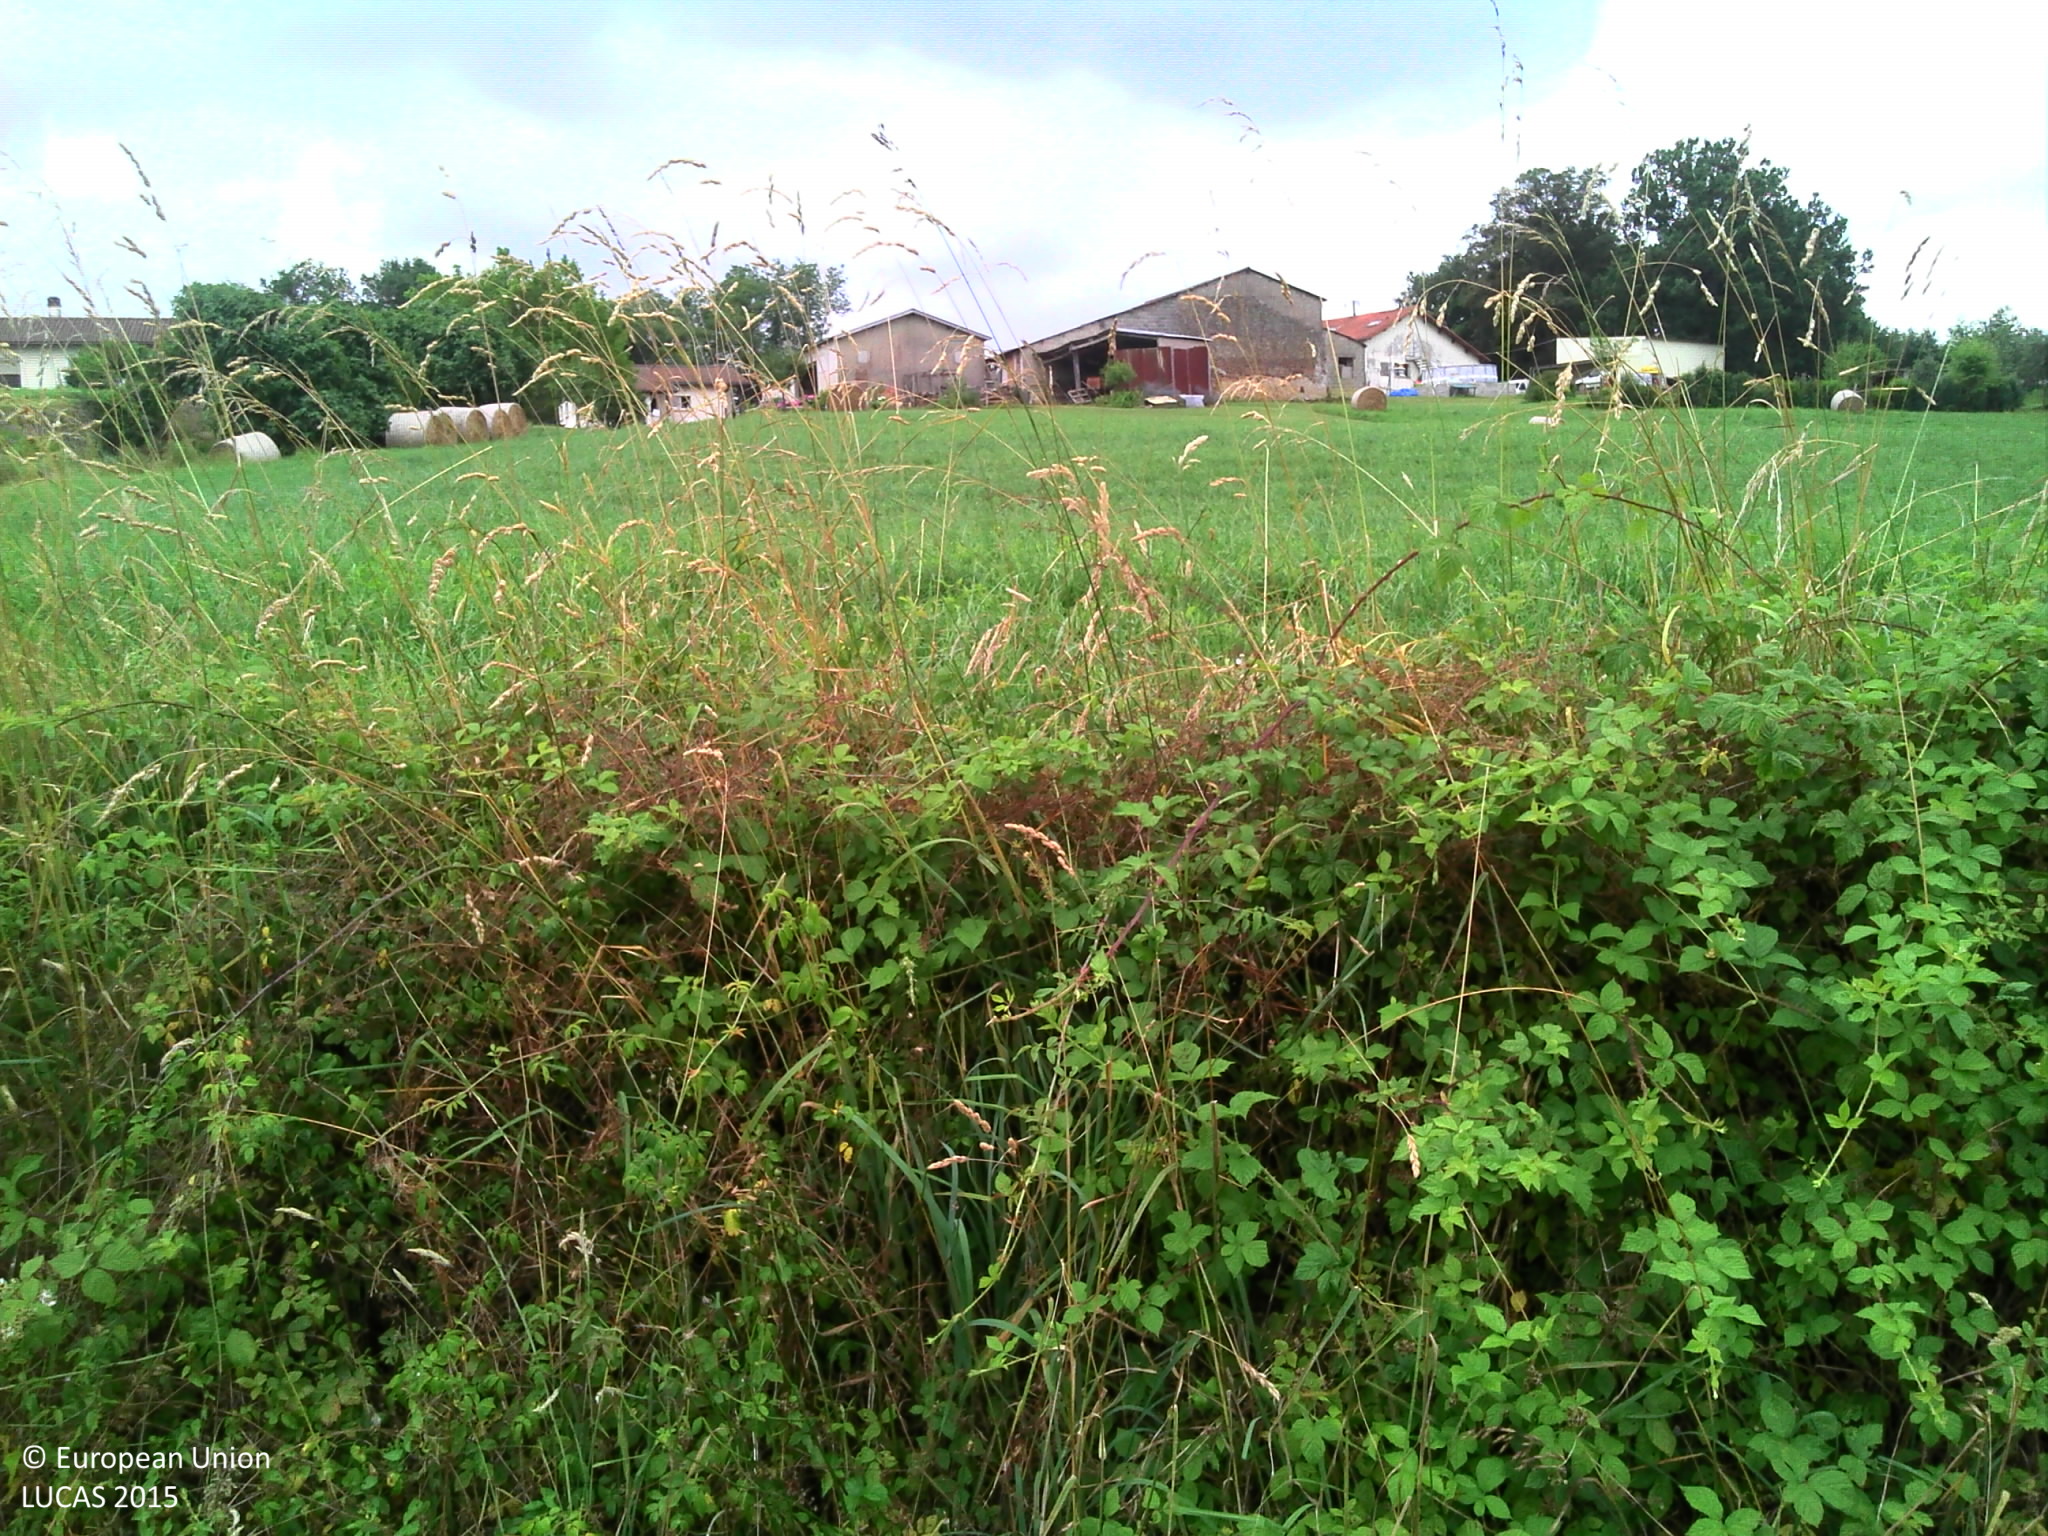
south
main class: Cropland
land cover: Maize
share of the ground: 50 - 75 %
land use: Agriculture (excluding fallow land and kitchen gardens)
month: July
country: FR
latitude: 43.6465
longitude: -0.7361
